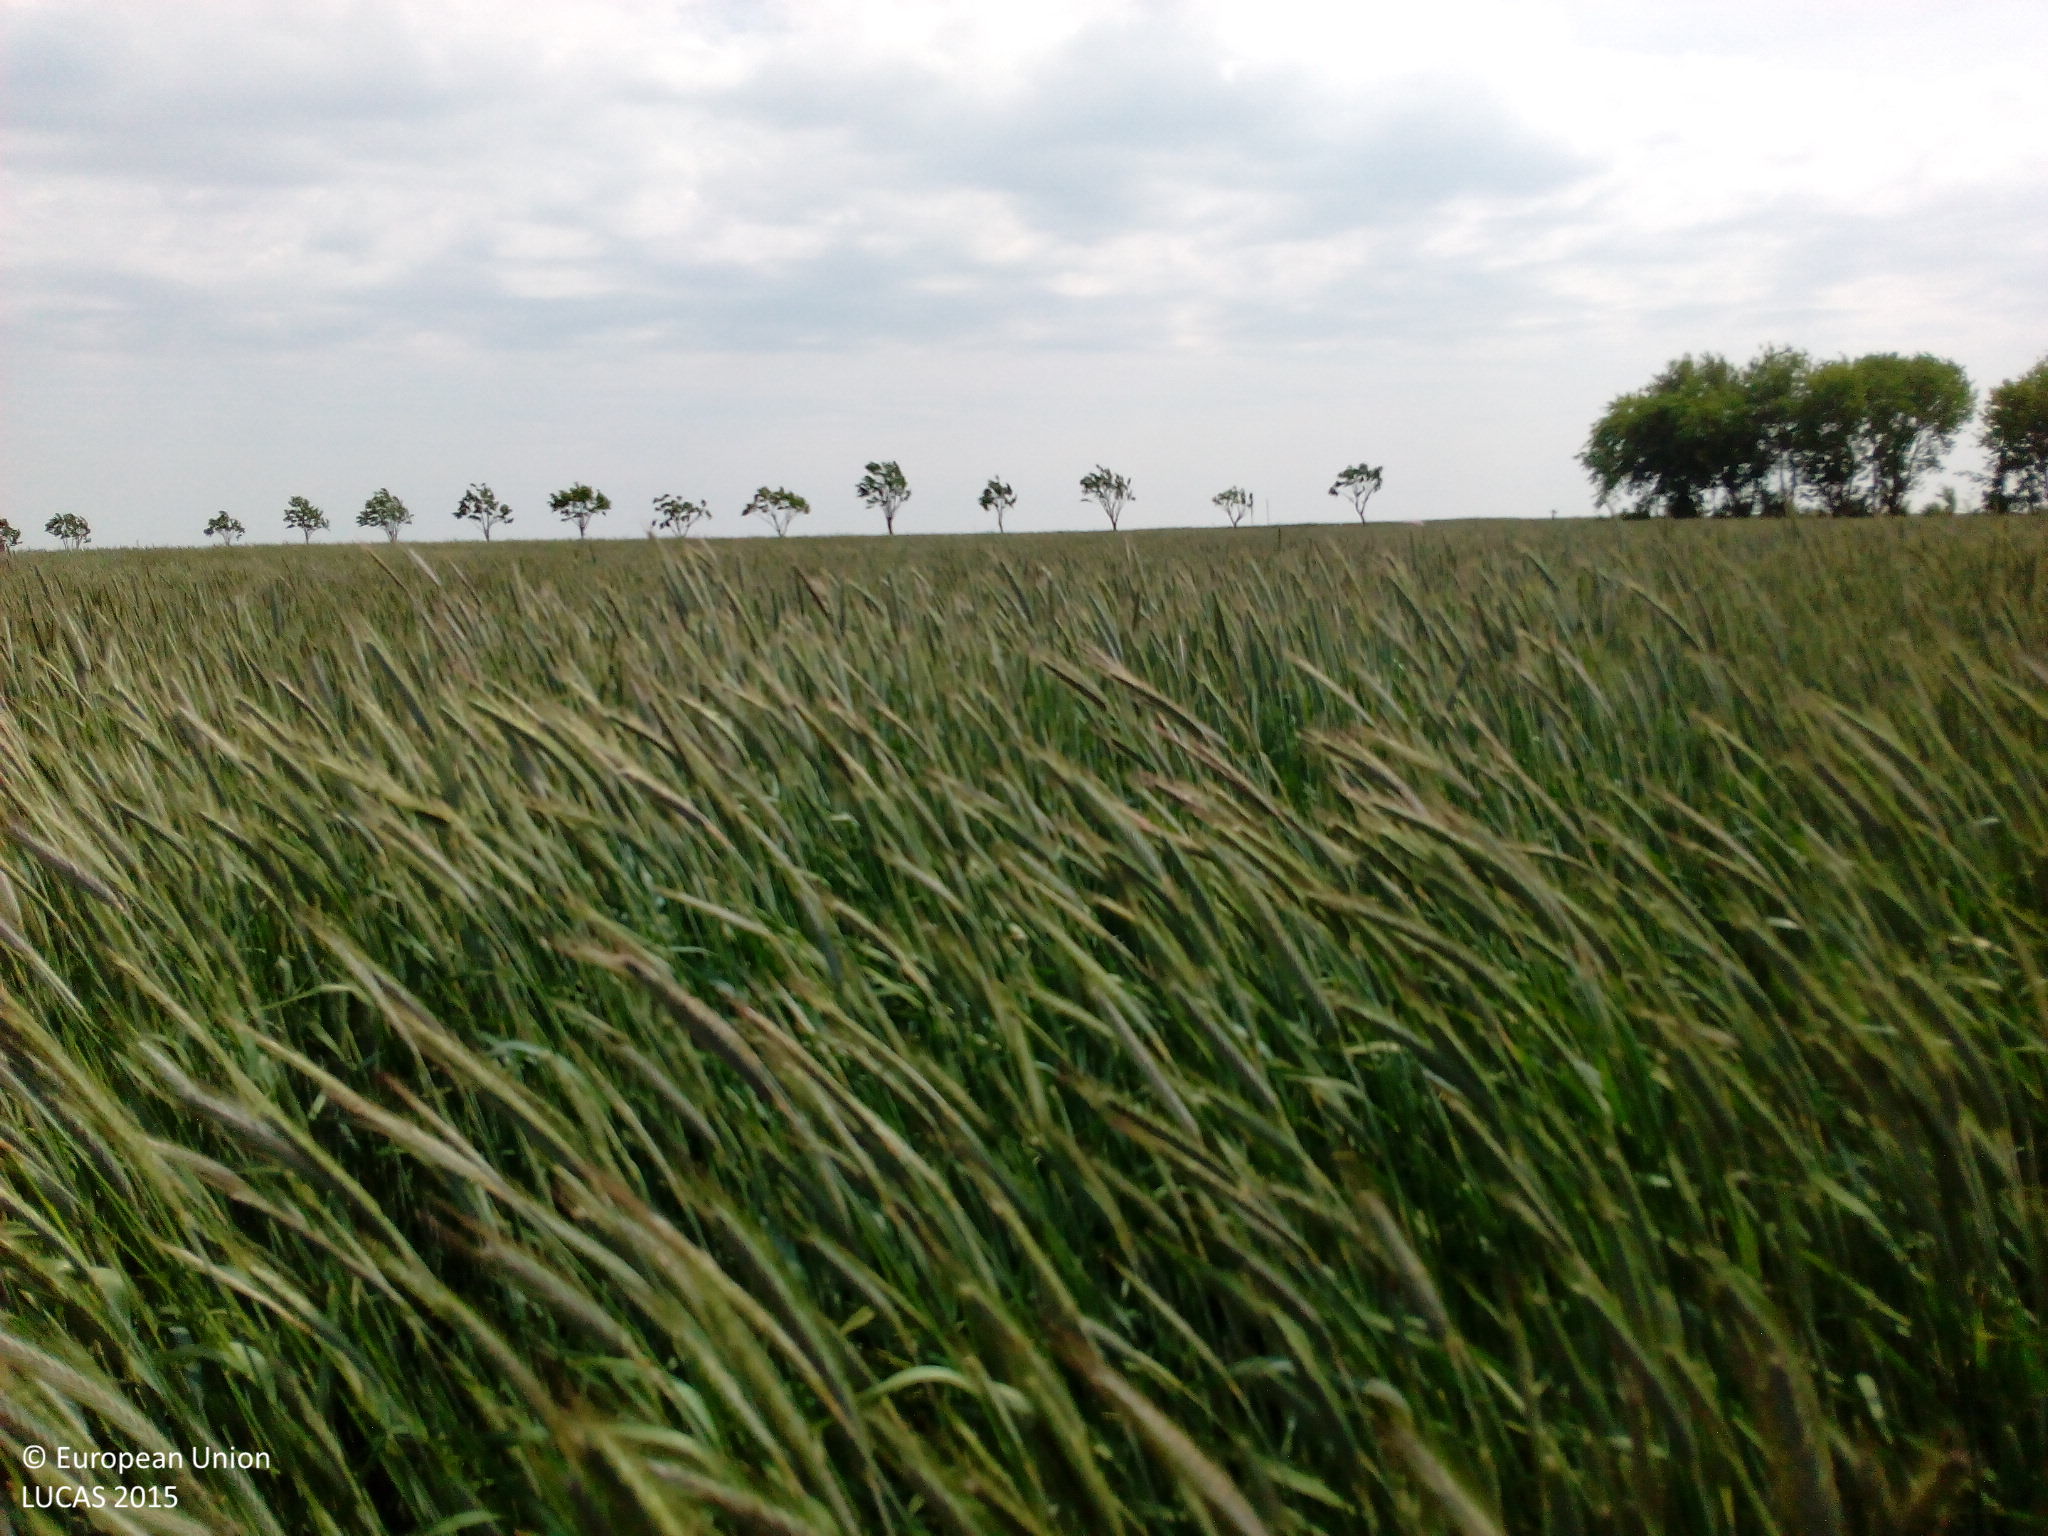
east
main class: Cropland
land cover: Rye
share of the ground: > 75 %
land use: Agriculture (excluding fallow land and kitchen gardens)
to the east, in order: Rye; Grass margins; Tracks; Grass margins; Rye; Grass margins; Paved roads, cycling and walking lanes; Grass margins; Paved roads, cycling and walking lanes; Lines of trees; Rye
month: May
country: DE
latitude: 52.0983
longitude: 12.5543
